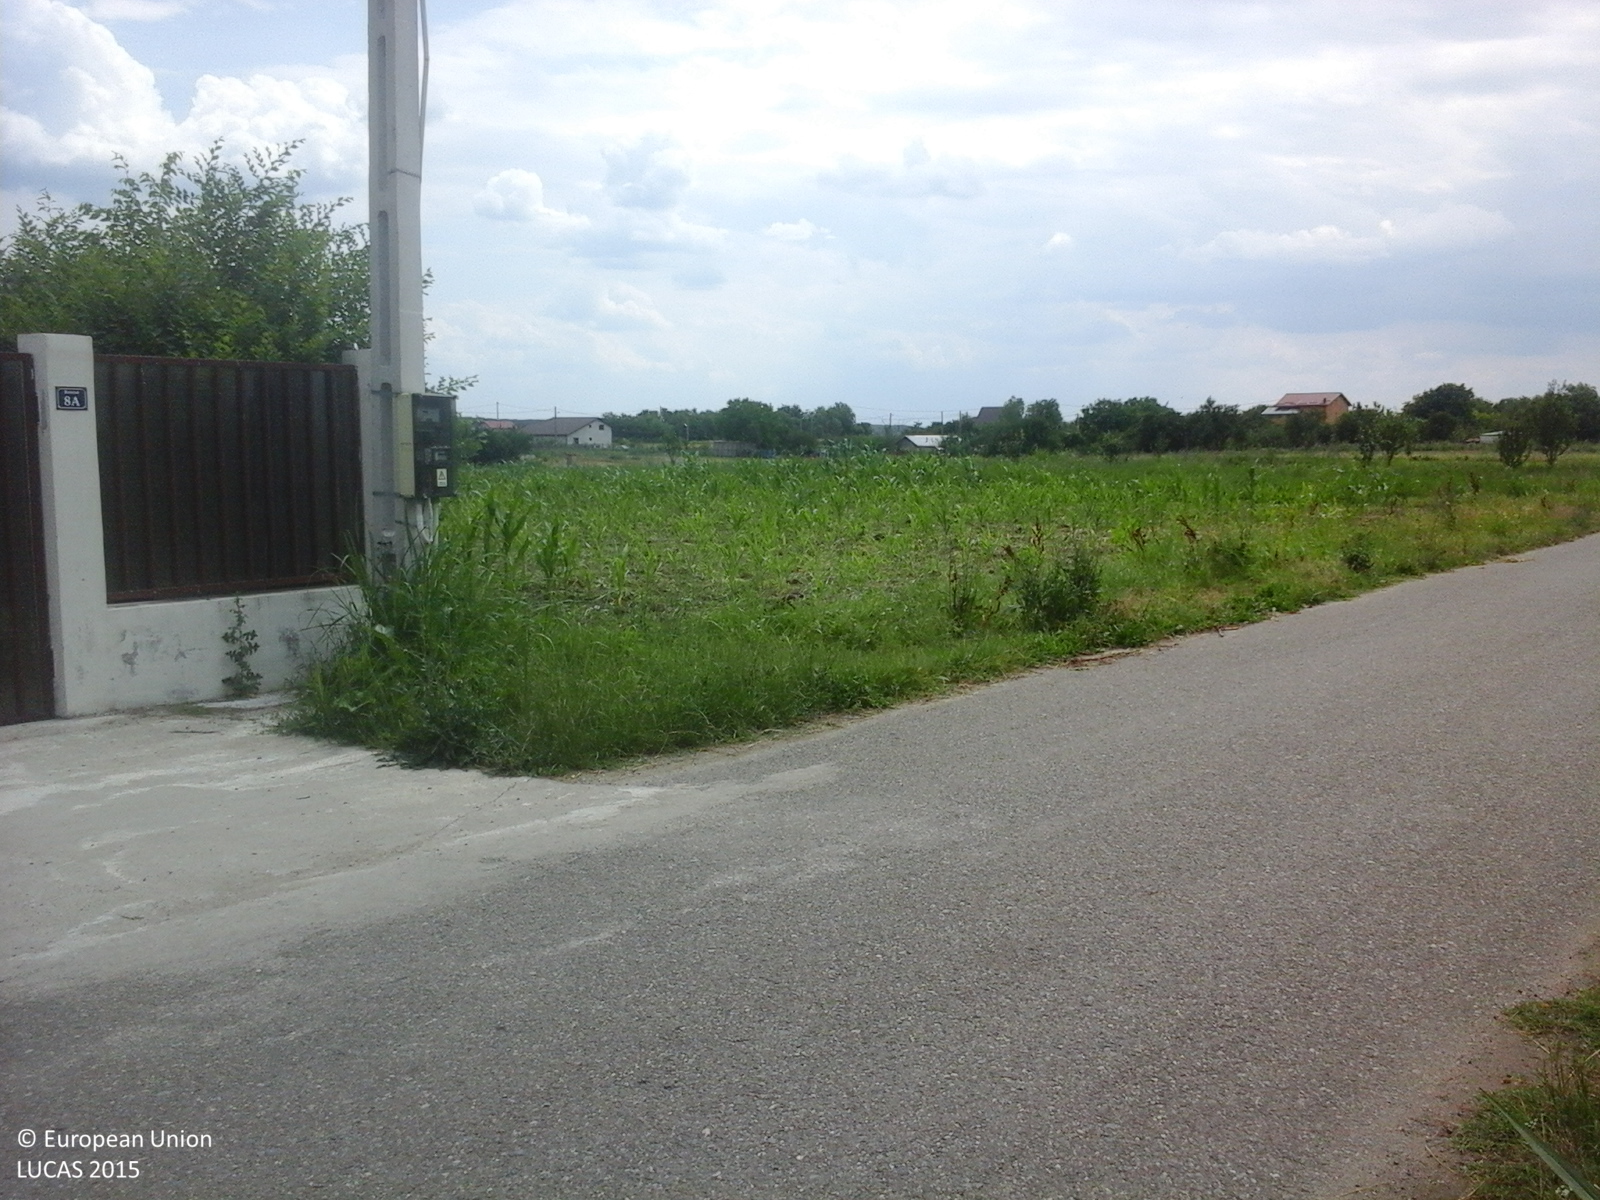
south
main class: Grassland
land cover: Grassland with sparse tree/shrub cover
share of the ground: > 75 %
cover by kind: herbaceous plants 95 %, broadleaved forest trees 5 %
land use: Agriculture (excluding fallow land and kitchen gardens)
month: June
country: RO
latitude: 44.5983
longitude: 26.2745
